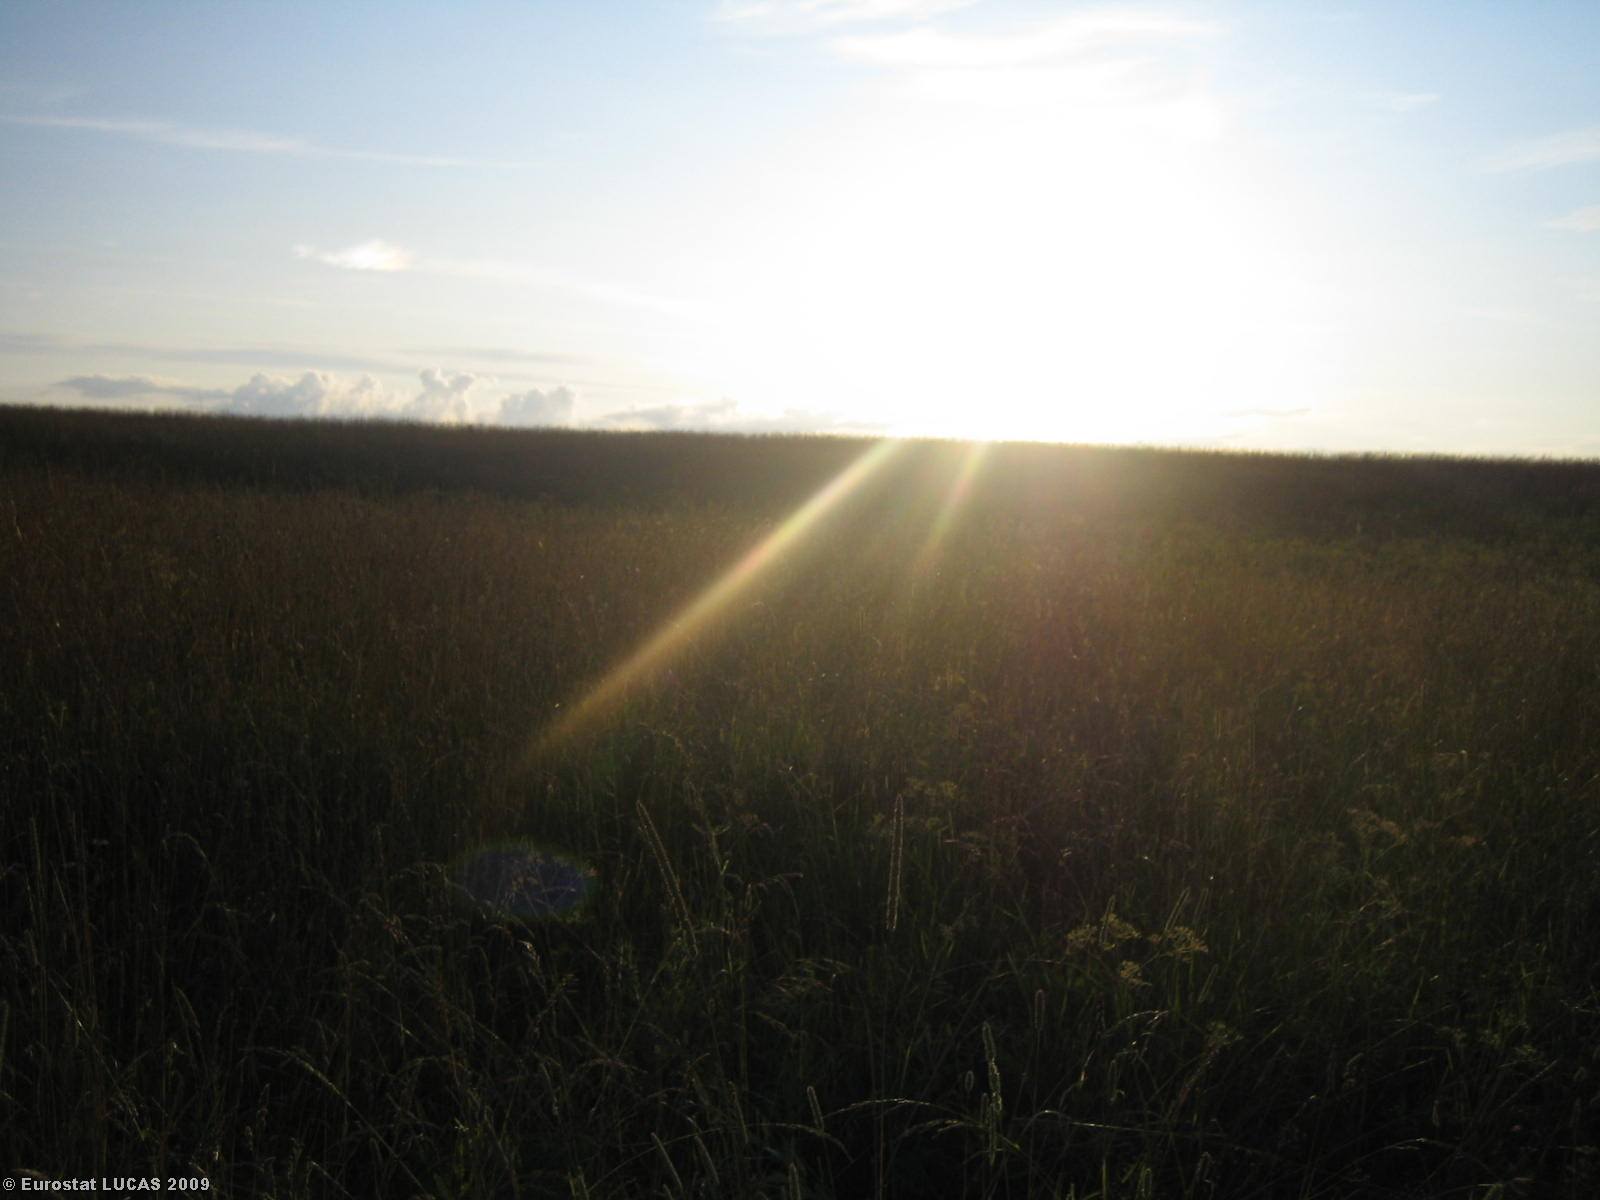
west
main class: Grassland
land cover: Grassland without tree/shrub cover
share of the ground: > 75 %
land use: Agriculture (excluding fallow land and kitchen gardens)
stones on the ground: < 10 %
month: July
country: LT
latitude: 55.8460
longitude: 26.0615
